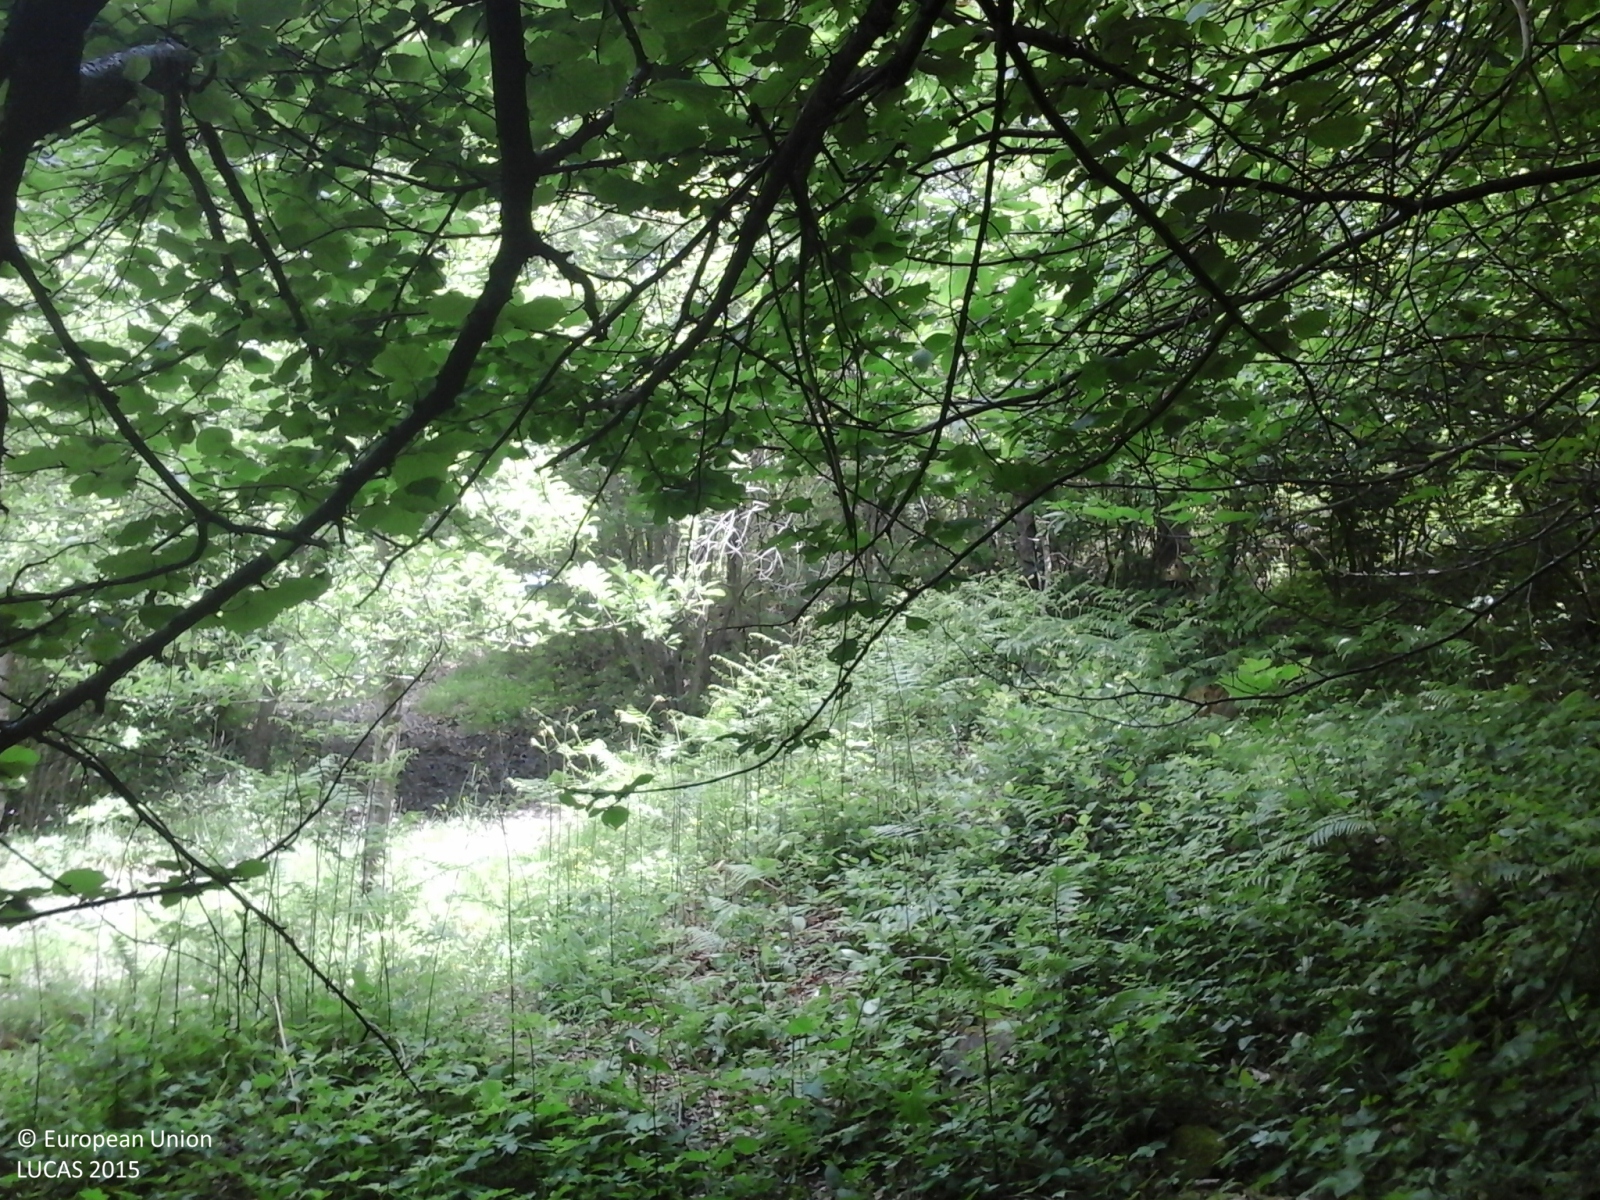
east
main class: Woodland
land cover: Broadleaved woodland
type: thermophilous deciduous forest
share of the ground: > 75 %
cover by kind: broadleaved forest trees 80 %, herbaceous plants 20 %
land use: Forestry
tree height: > 5 m
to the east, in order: Broadleaved woodland; Tracks; Broadleaved woodland; Fences; Grass margins; Paved roads, cycling and walking lanes; Ditches and canals; Grass margins; Broadleaved woodland
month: May
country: IT
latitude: 44.4222
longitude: 9.6867
